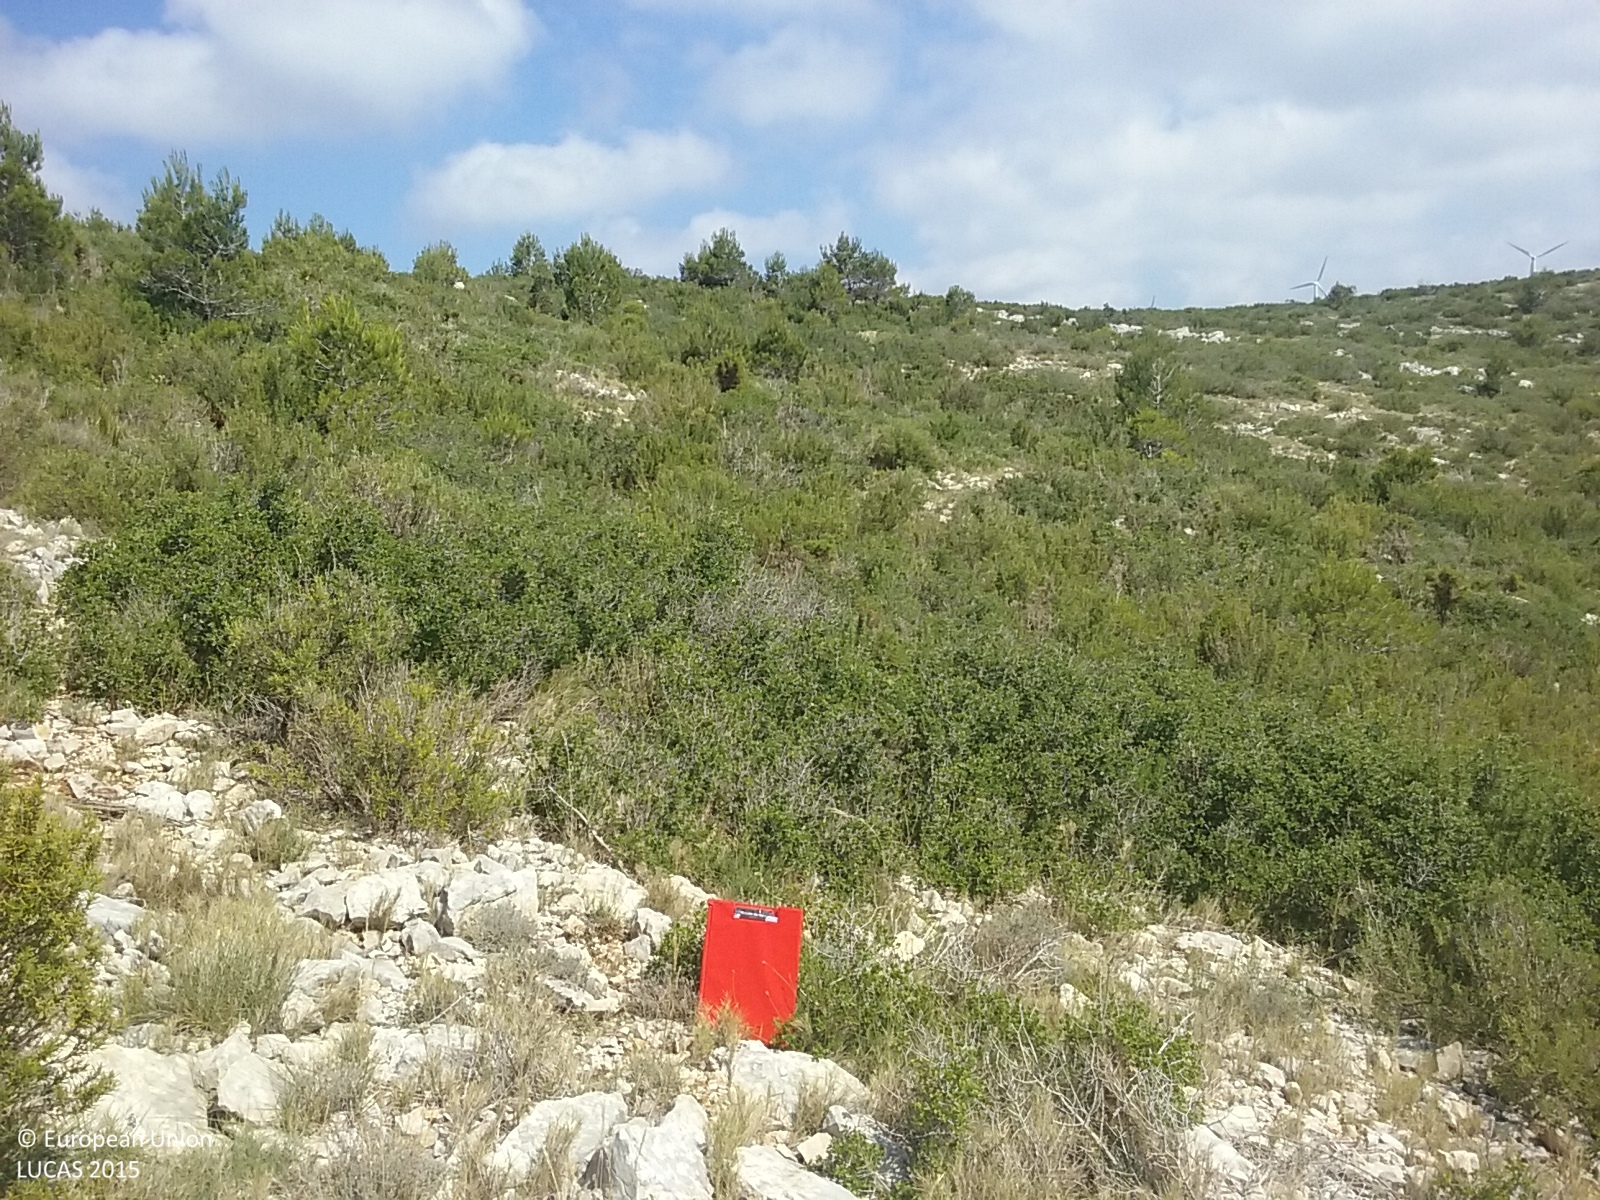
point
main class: Shrubland
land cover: Shrubland with sparse tree cover
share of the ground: > 75 %
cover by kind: shrubs 80 %, herbaceous plants 10 %, coniferous forest trees 5 %, unconsolidated bare surface 5 %
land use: Semi-natural and natural areas not in use
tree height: < 5 m
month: June
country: ES
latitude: 40.8938
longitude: 0.6524
